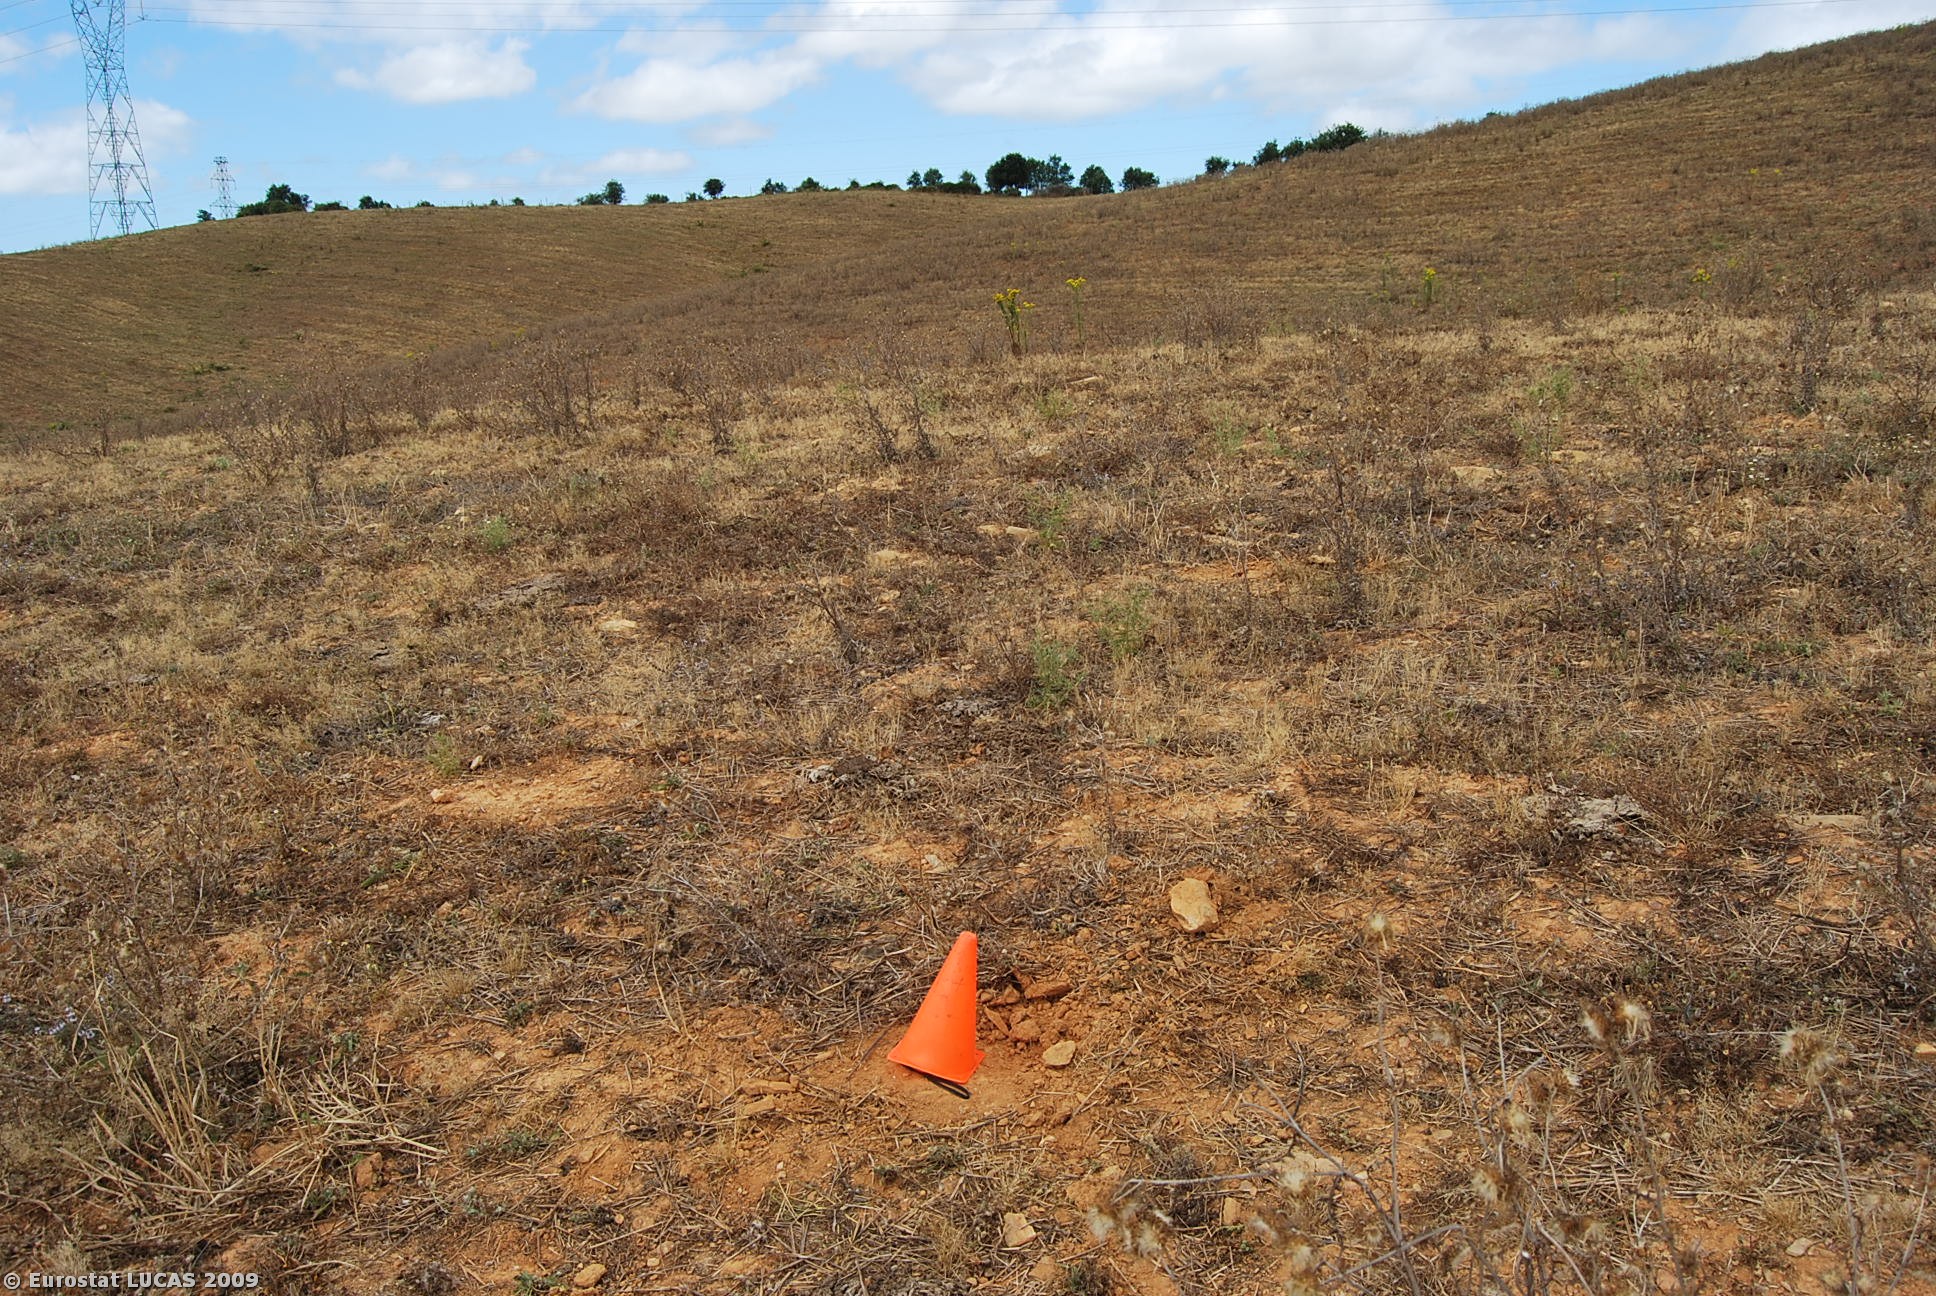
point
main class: Grassland
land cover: Grassland without tree/shrub cover
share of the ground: > 75 %
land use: Agriculture (excluding fallow land and kitchen gardens)
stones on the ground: 10 - 25 %
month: June
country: PT
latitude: 37.7055
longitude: -8.6309
